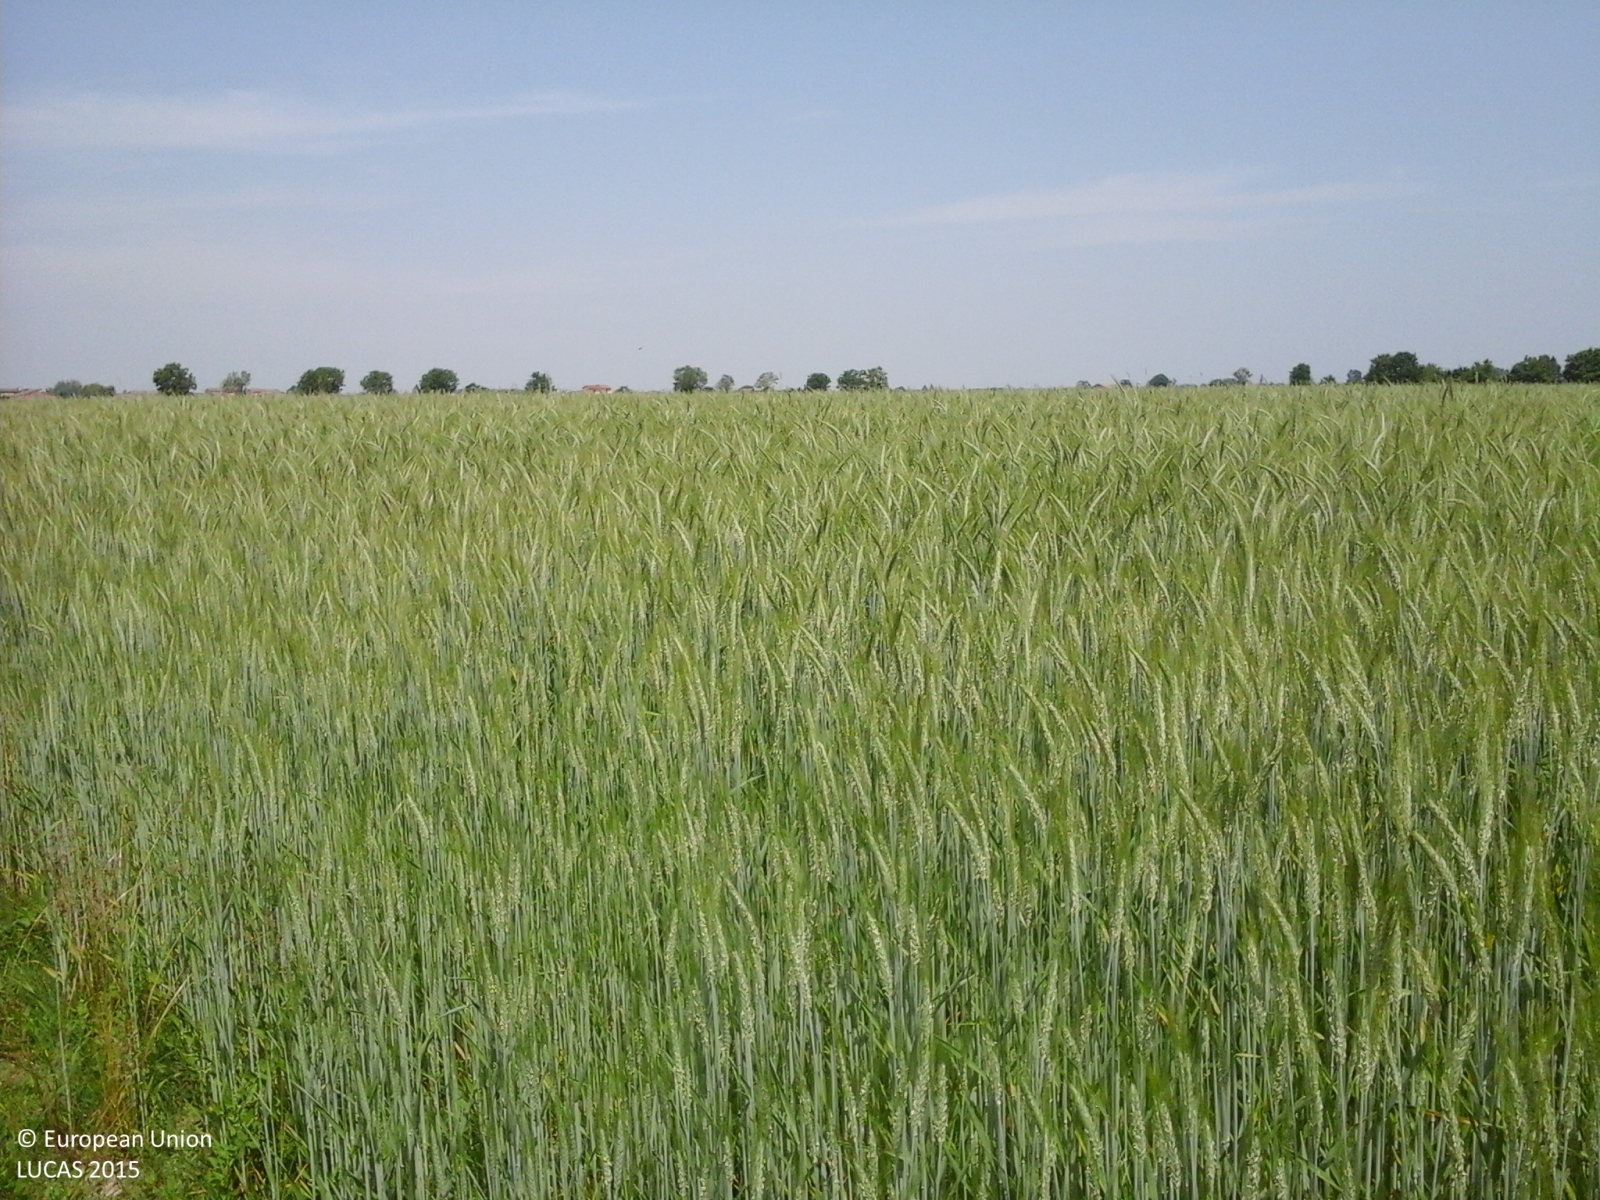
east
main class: Cropland
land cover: Common wheat
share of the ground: > 75 %
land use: Agriculture (excluding fallow land and kitchen gardens)
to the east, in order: Common wheat; Ditches and canals; Common wheat; Grass margins; Tracks; Ditches and canals; Maize
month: May
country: IT
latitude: 44.9453
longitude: 10.2656
